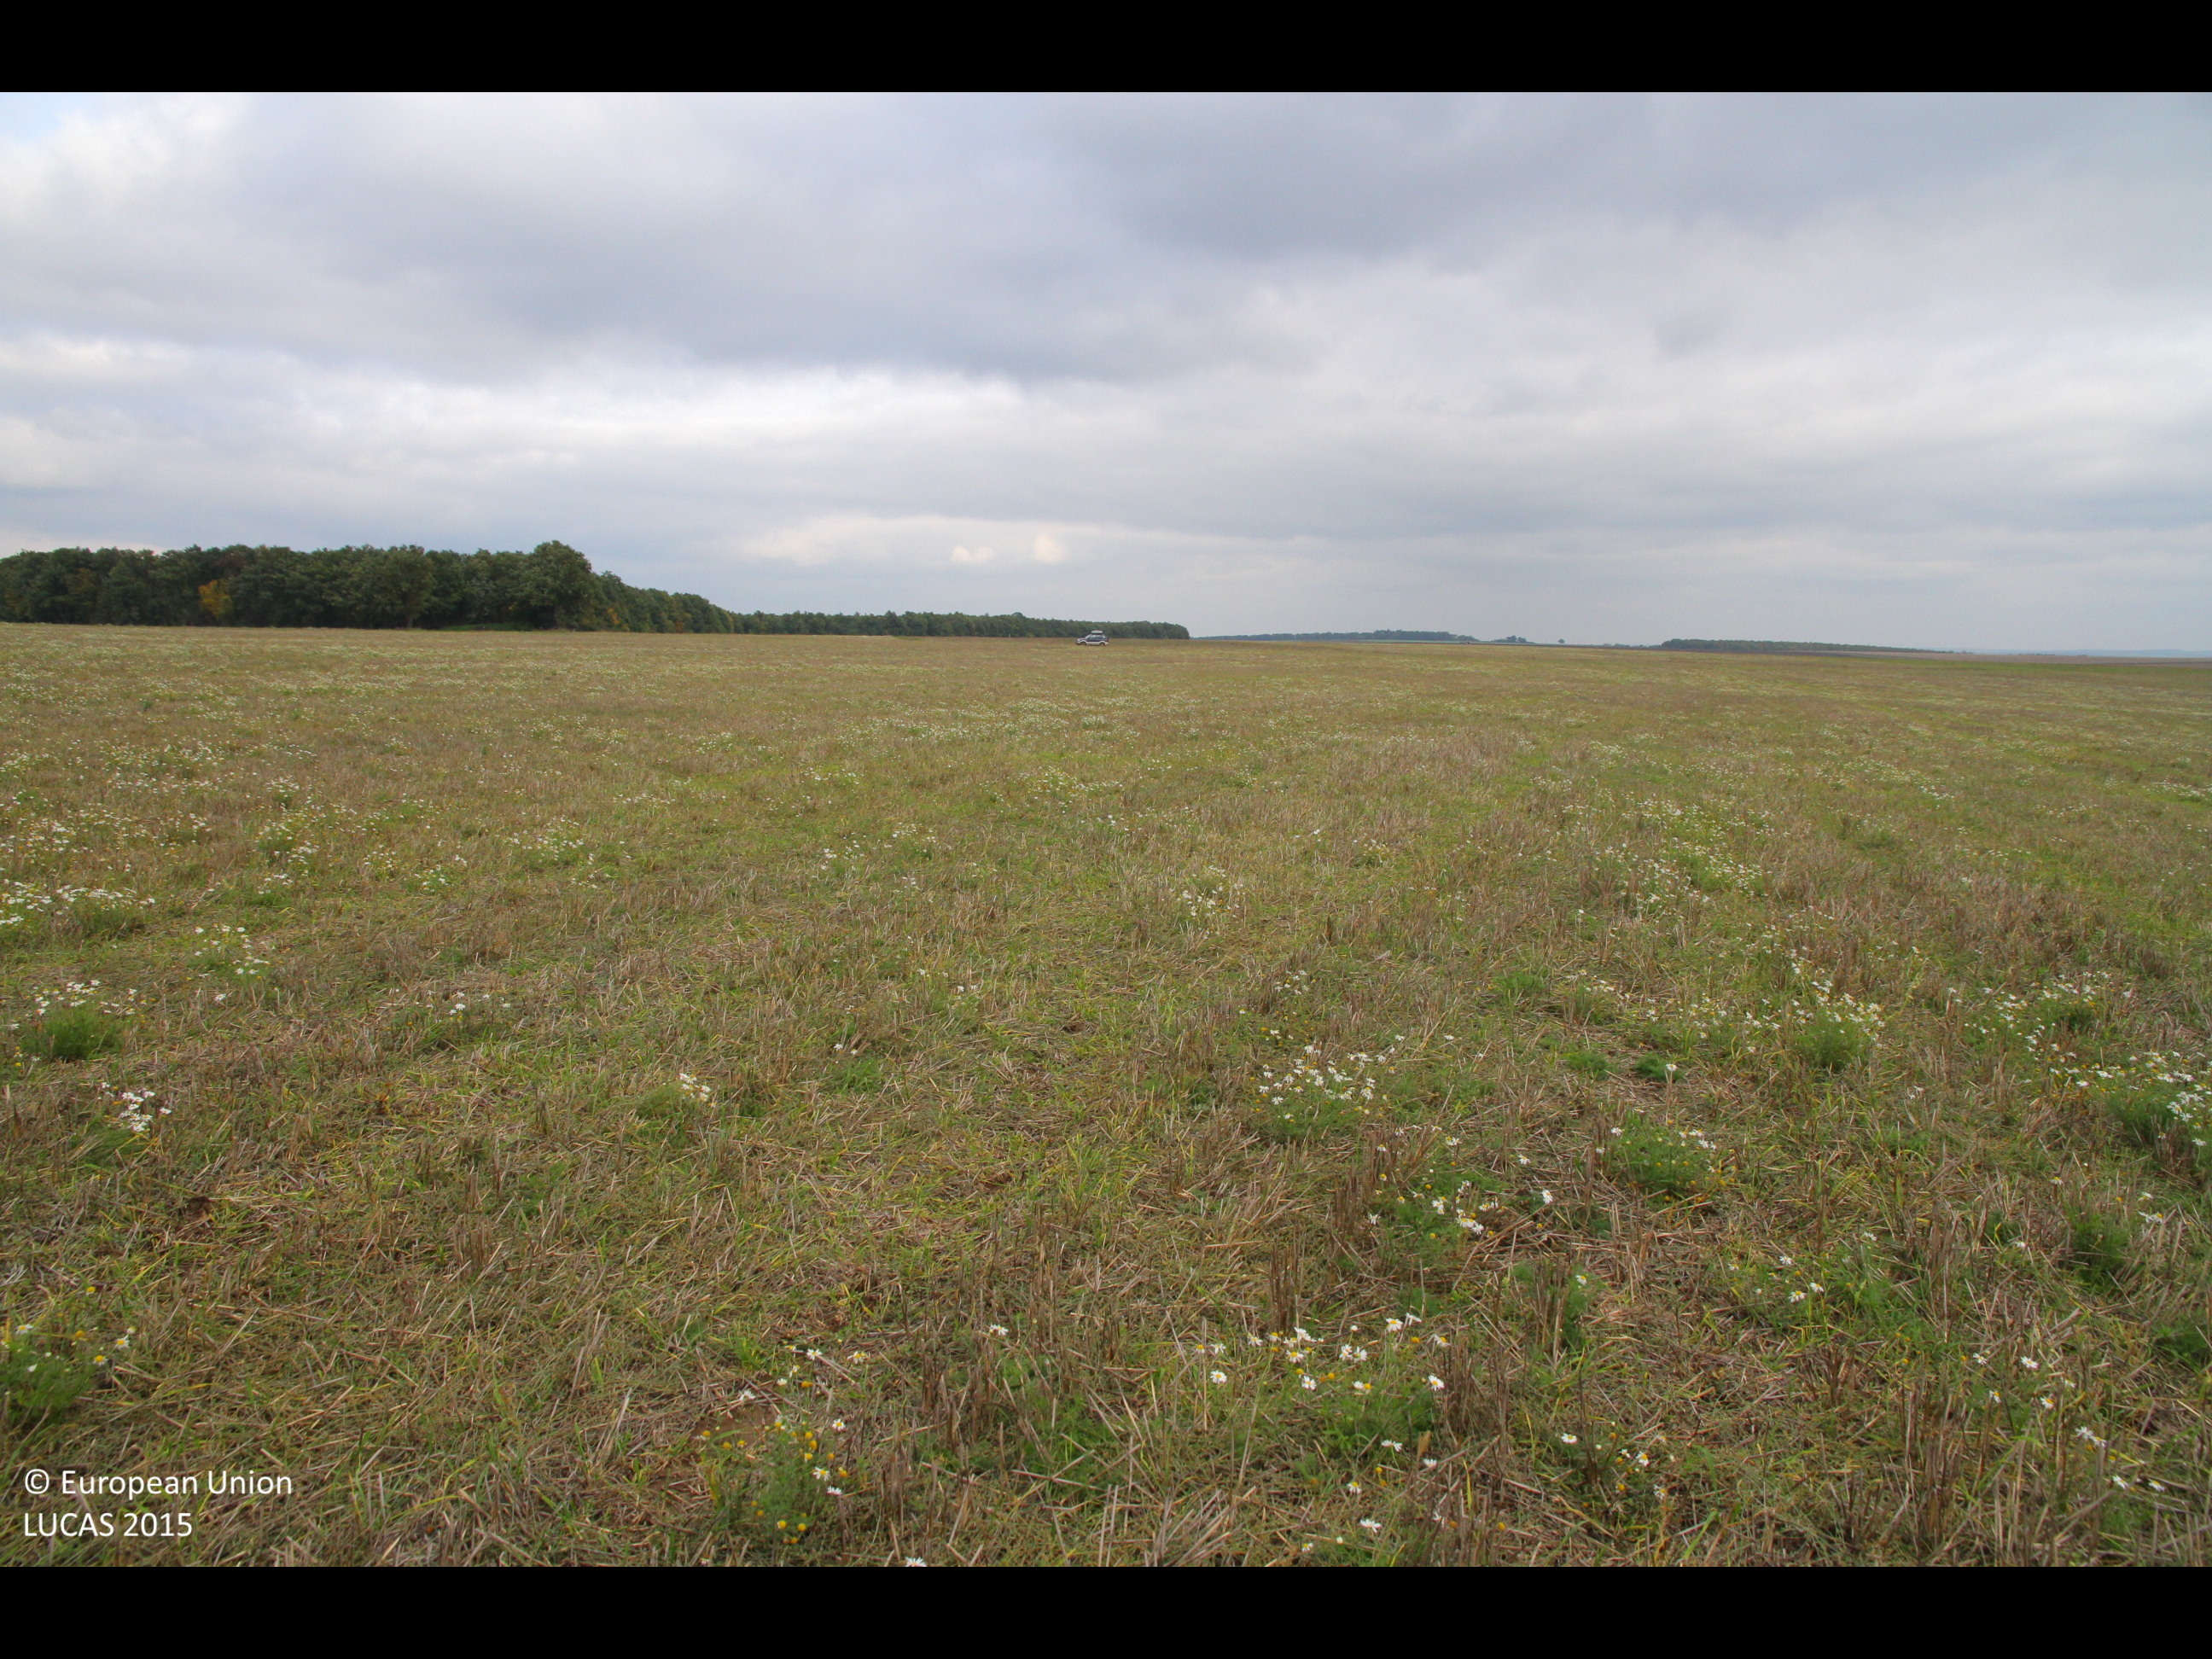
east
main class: Cropland
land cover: Common wheat
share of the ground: < 10 %
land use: Agriculture (excluding fallow land and kitchen gardens)
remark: Harvested field
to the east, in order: Common wheat; Tracks; Common wheat
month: October
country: BG
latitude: 43.6054
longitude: 26.9542
